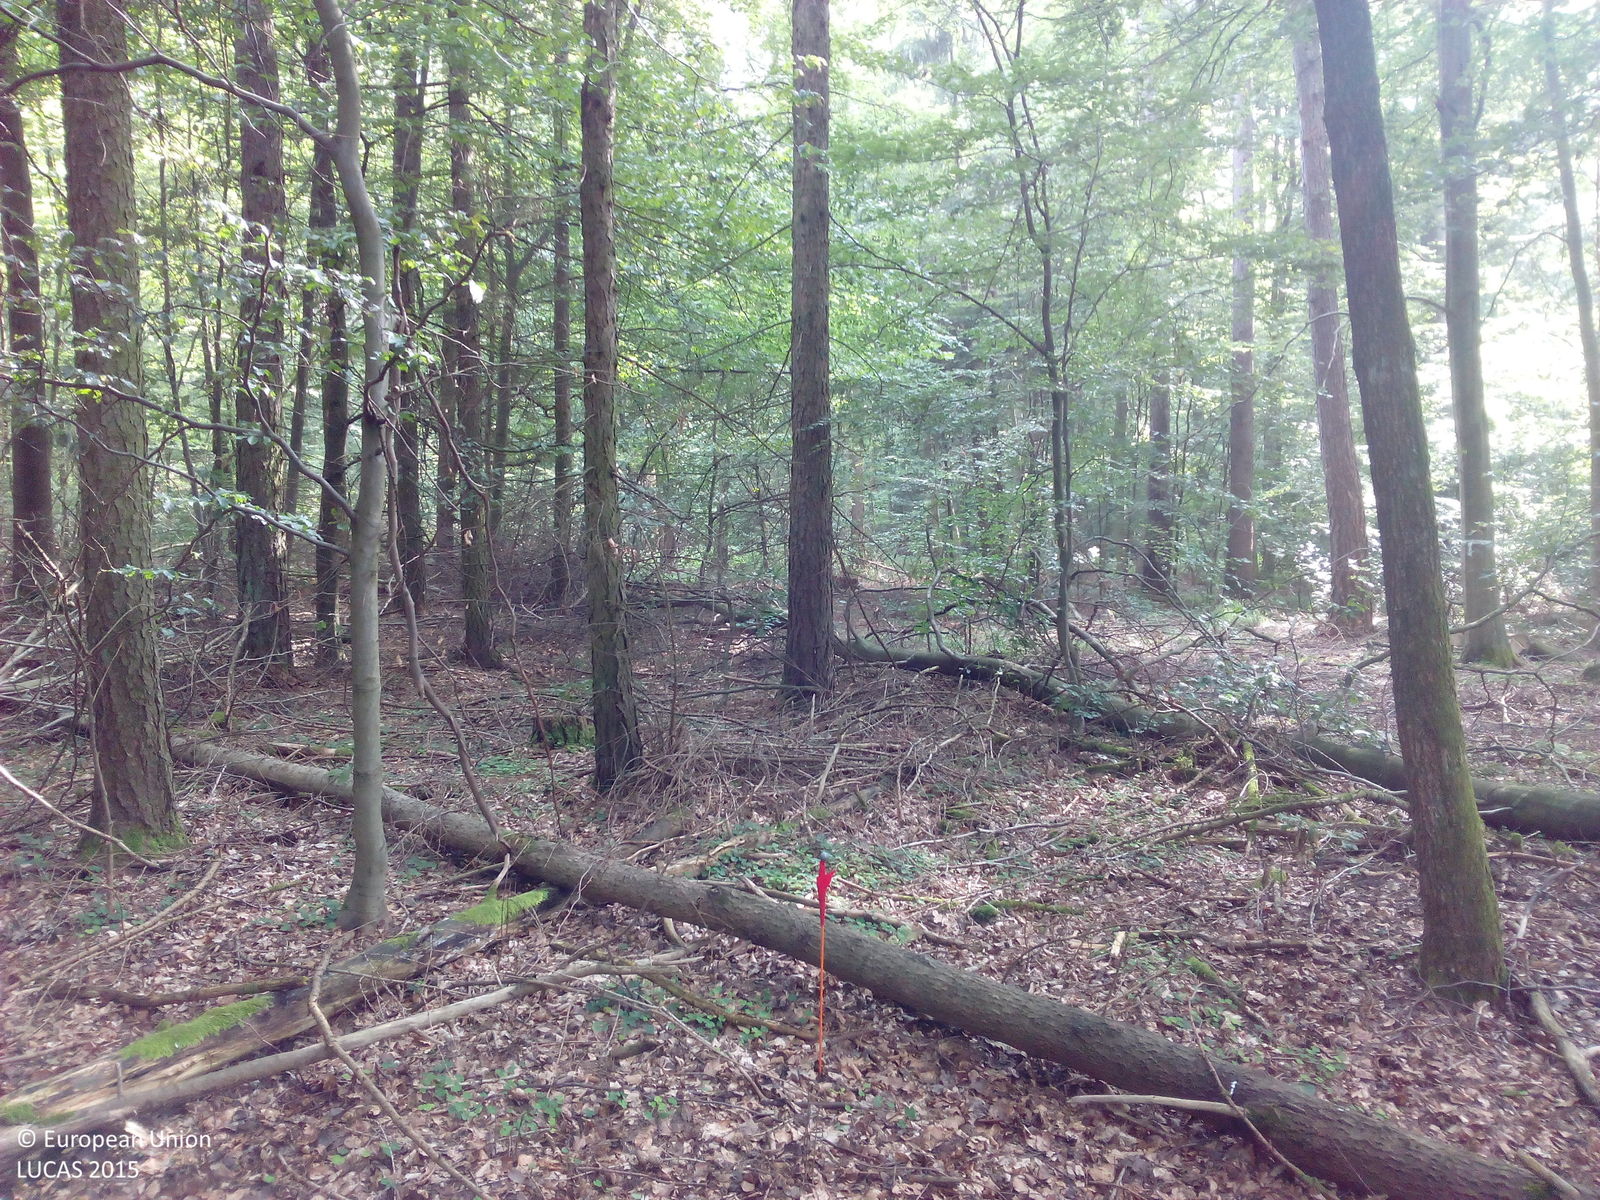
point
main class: Woodland
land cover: Spruce dominated mixed woodland
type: hemiboreal forest and nemoral coniferous forest and mixed broadleaved-coniferous forest
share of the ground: > 75 %
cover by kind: coniferous forest trees 60 %, broadleaved forest trees 40 %
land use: Forestry
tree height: > 5 m
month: September
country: DE
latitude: 51.3887
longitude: 9.8420
